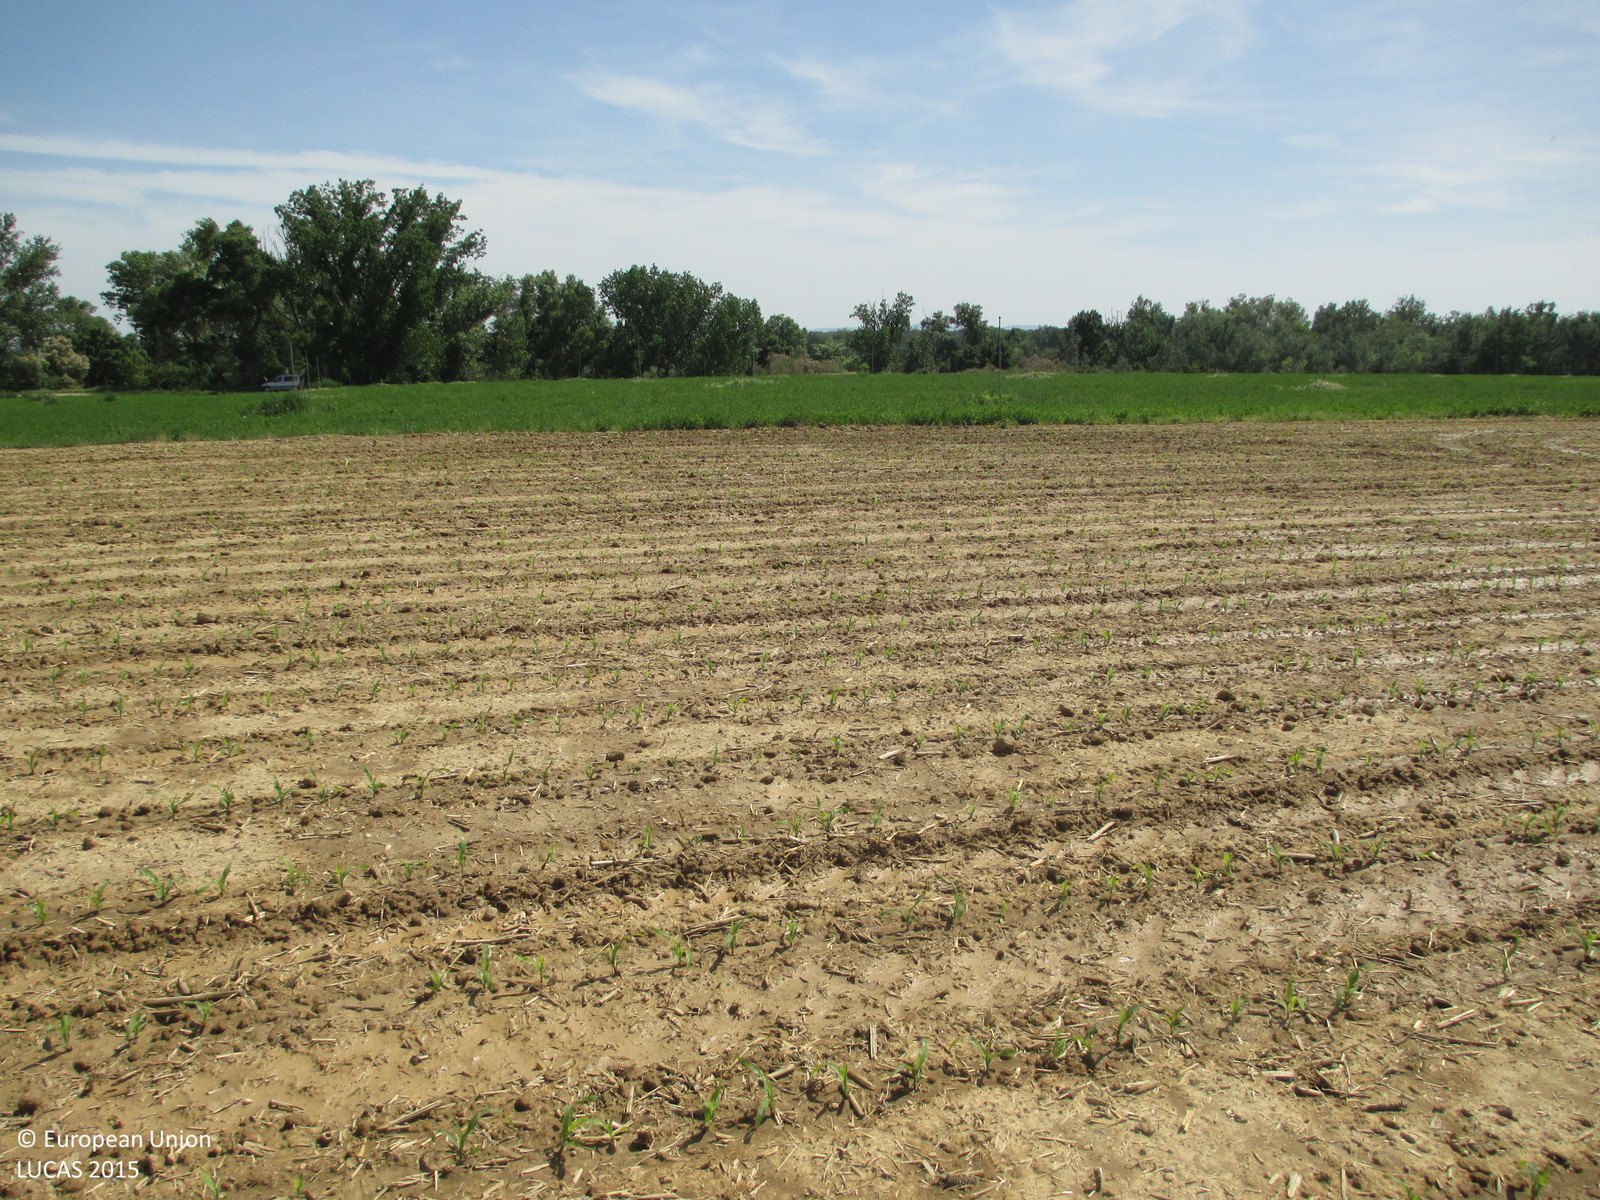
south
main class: Cropland
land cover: Maize
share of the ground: 10 - 25 %
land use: Agriculture (excluding fallow land and kitchen gardens)
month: May
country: ES
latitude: 41.9218
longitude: -0.3541
